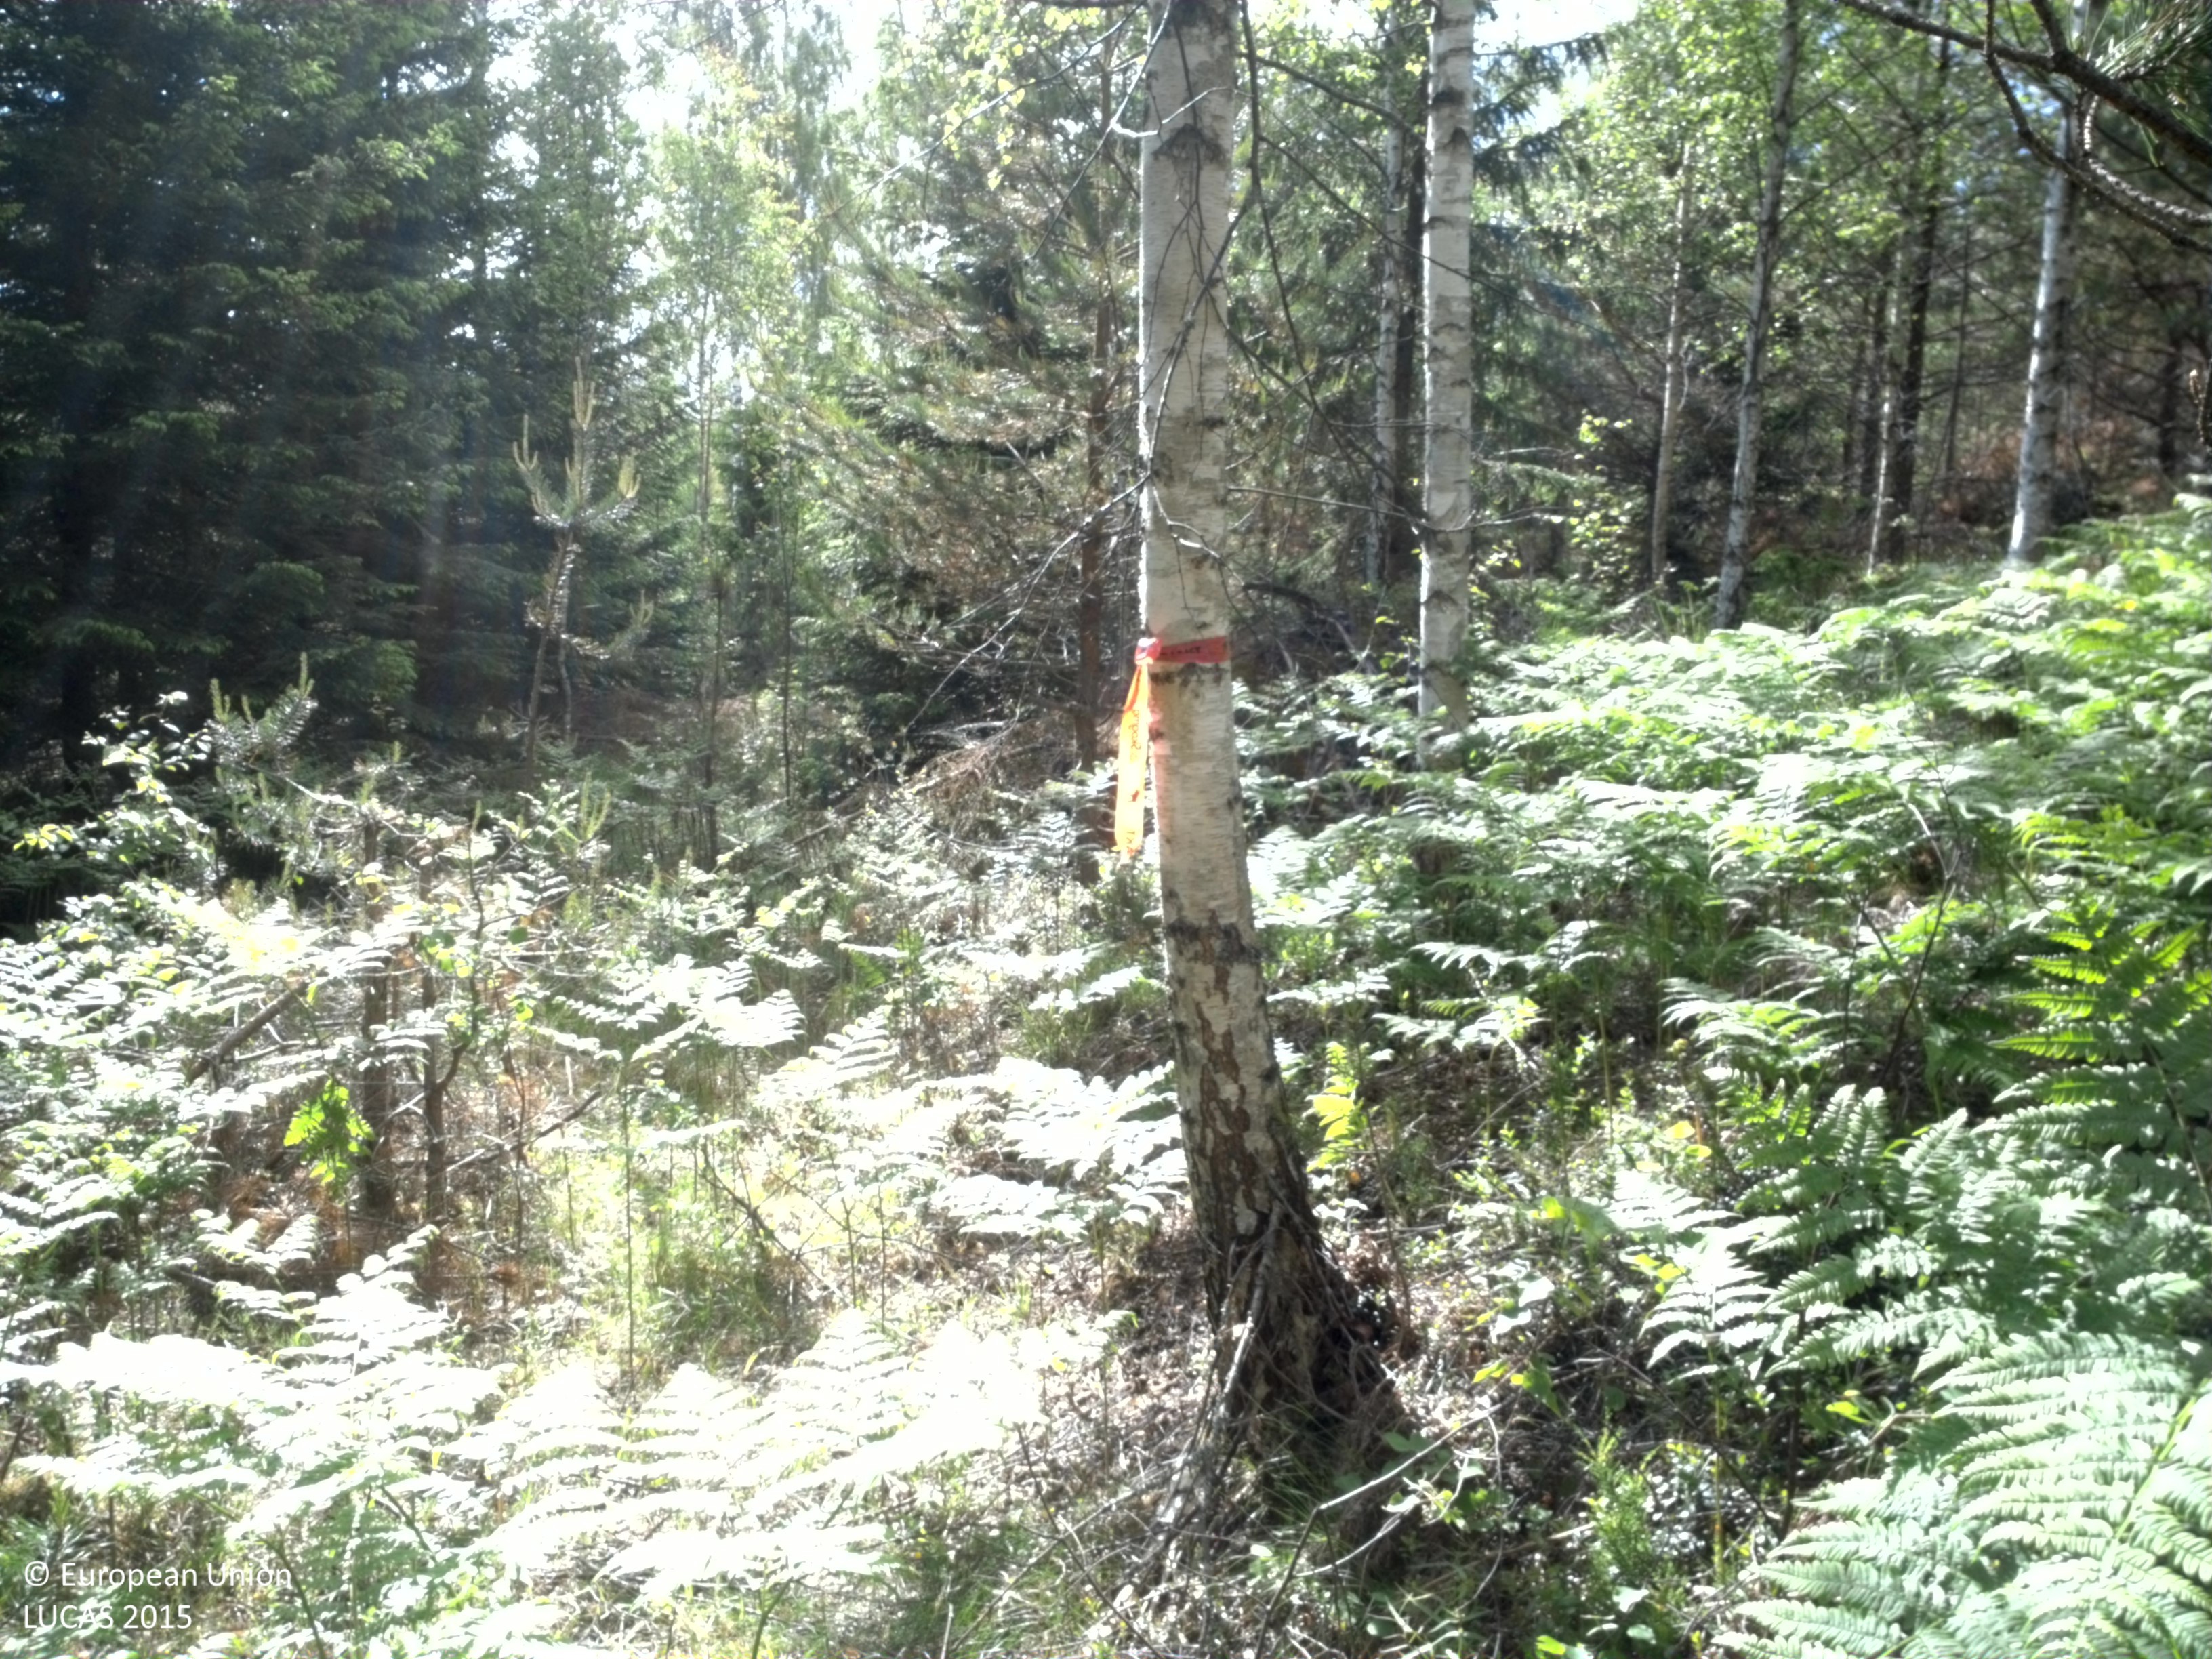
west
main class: Woodland
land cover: Pine dominated mixed woodland
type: boreal forest
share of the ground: 25 - 50 %
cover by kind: herbaceous plants 50 %, coniferous forest trees 30 %, broadleaved forest trees 15 %, lichens and mosses 5 %
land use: Forestry
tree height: < 5 m
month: June
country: SE
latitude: 58.5919
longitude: 15.5509
